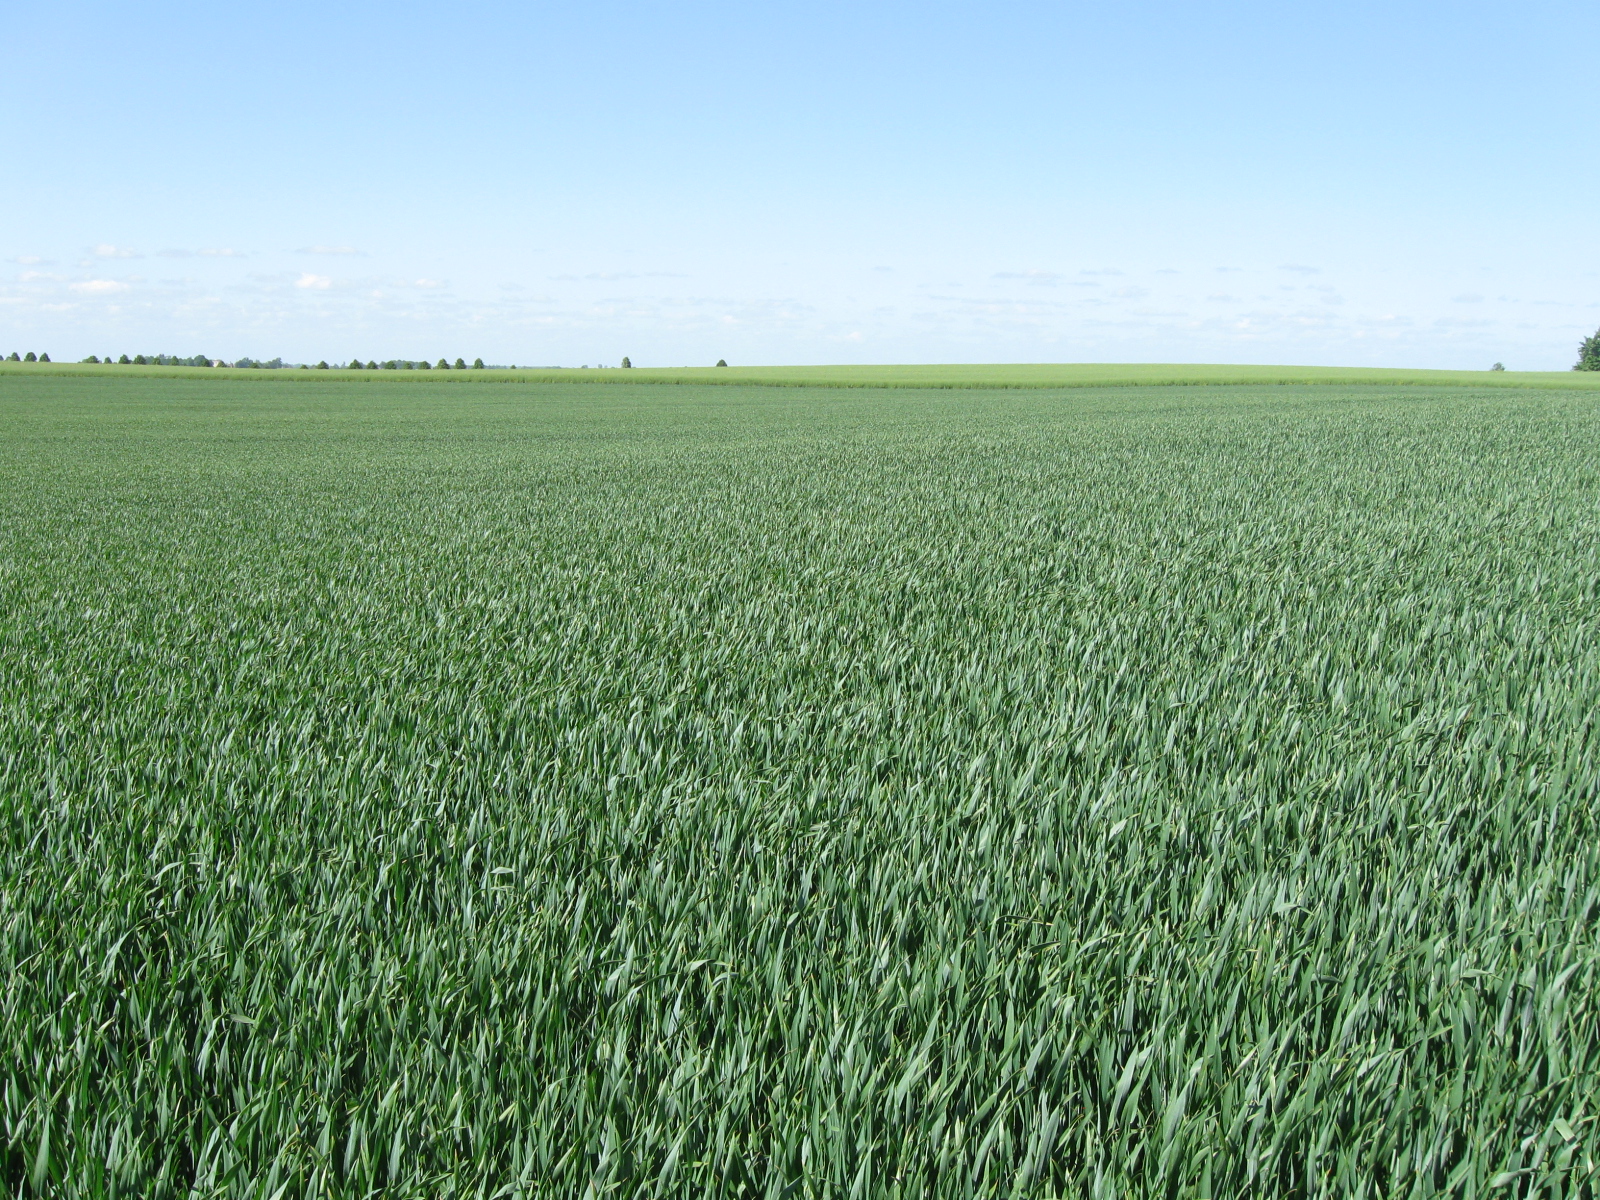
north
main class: Cropland
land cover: Common wheat
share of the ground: > 75 %
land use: Agriculture (excluding fallow land and kitchen gardens)
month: June
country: LT
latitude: 54.4225
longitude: 23.7264
